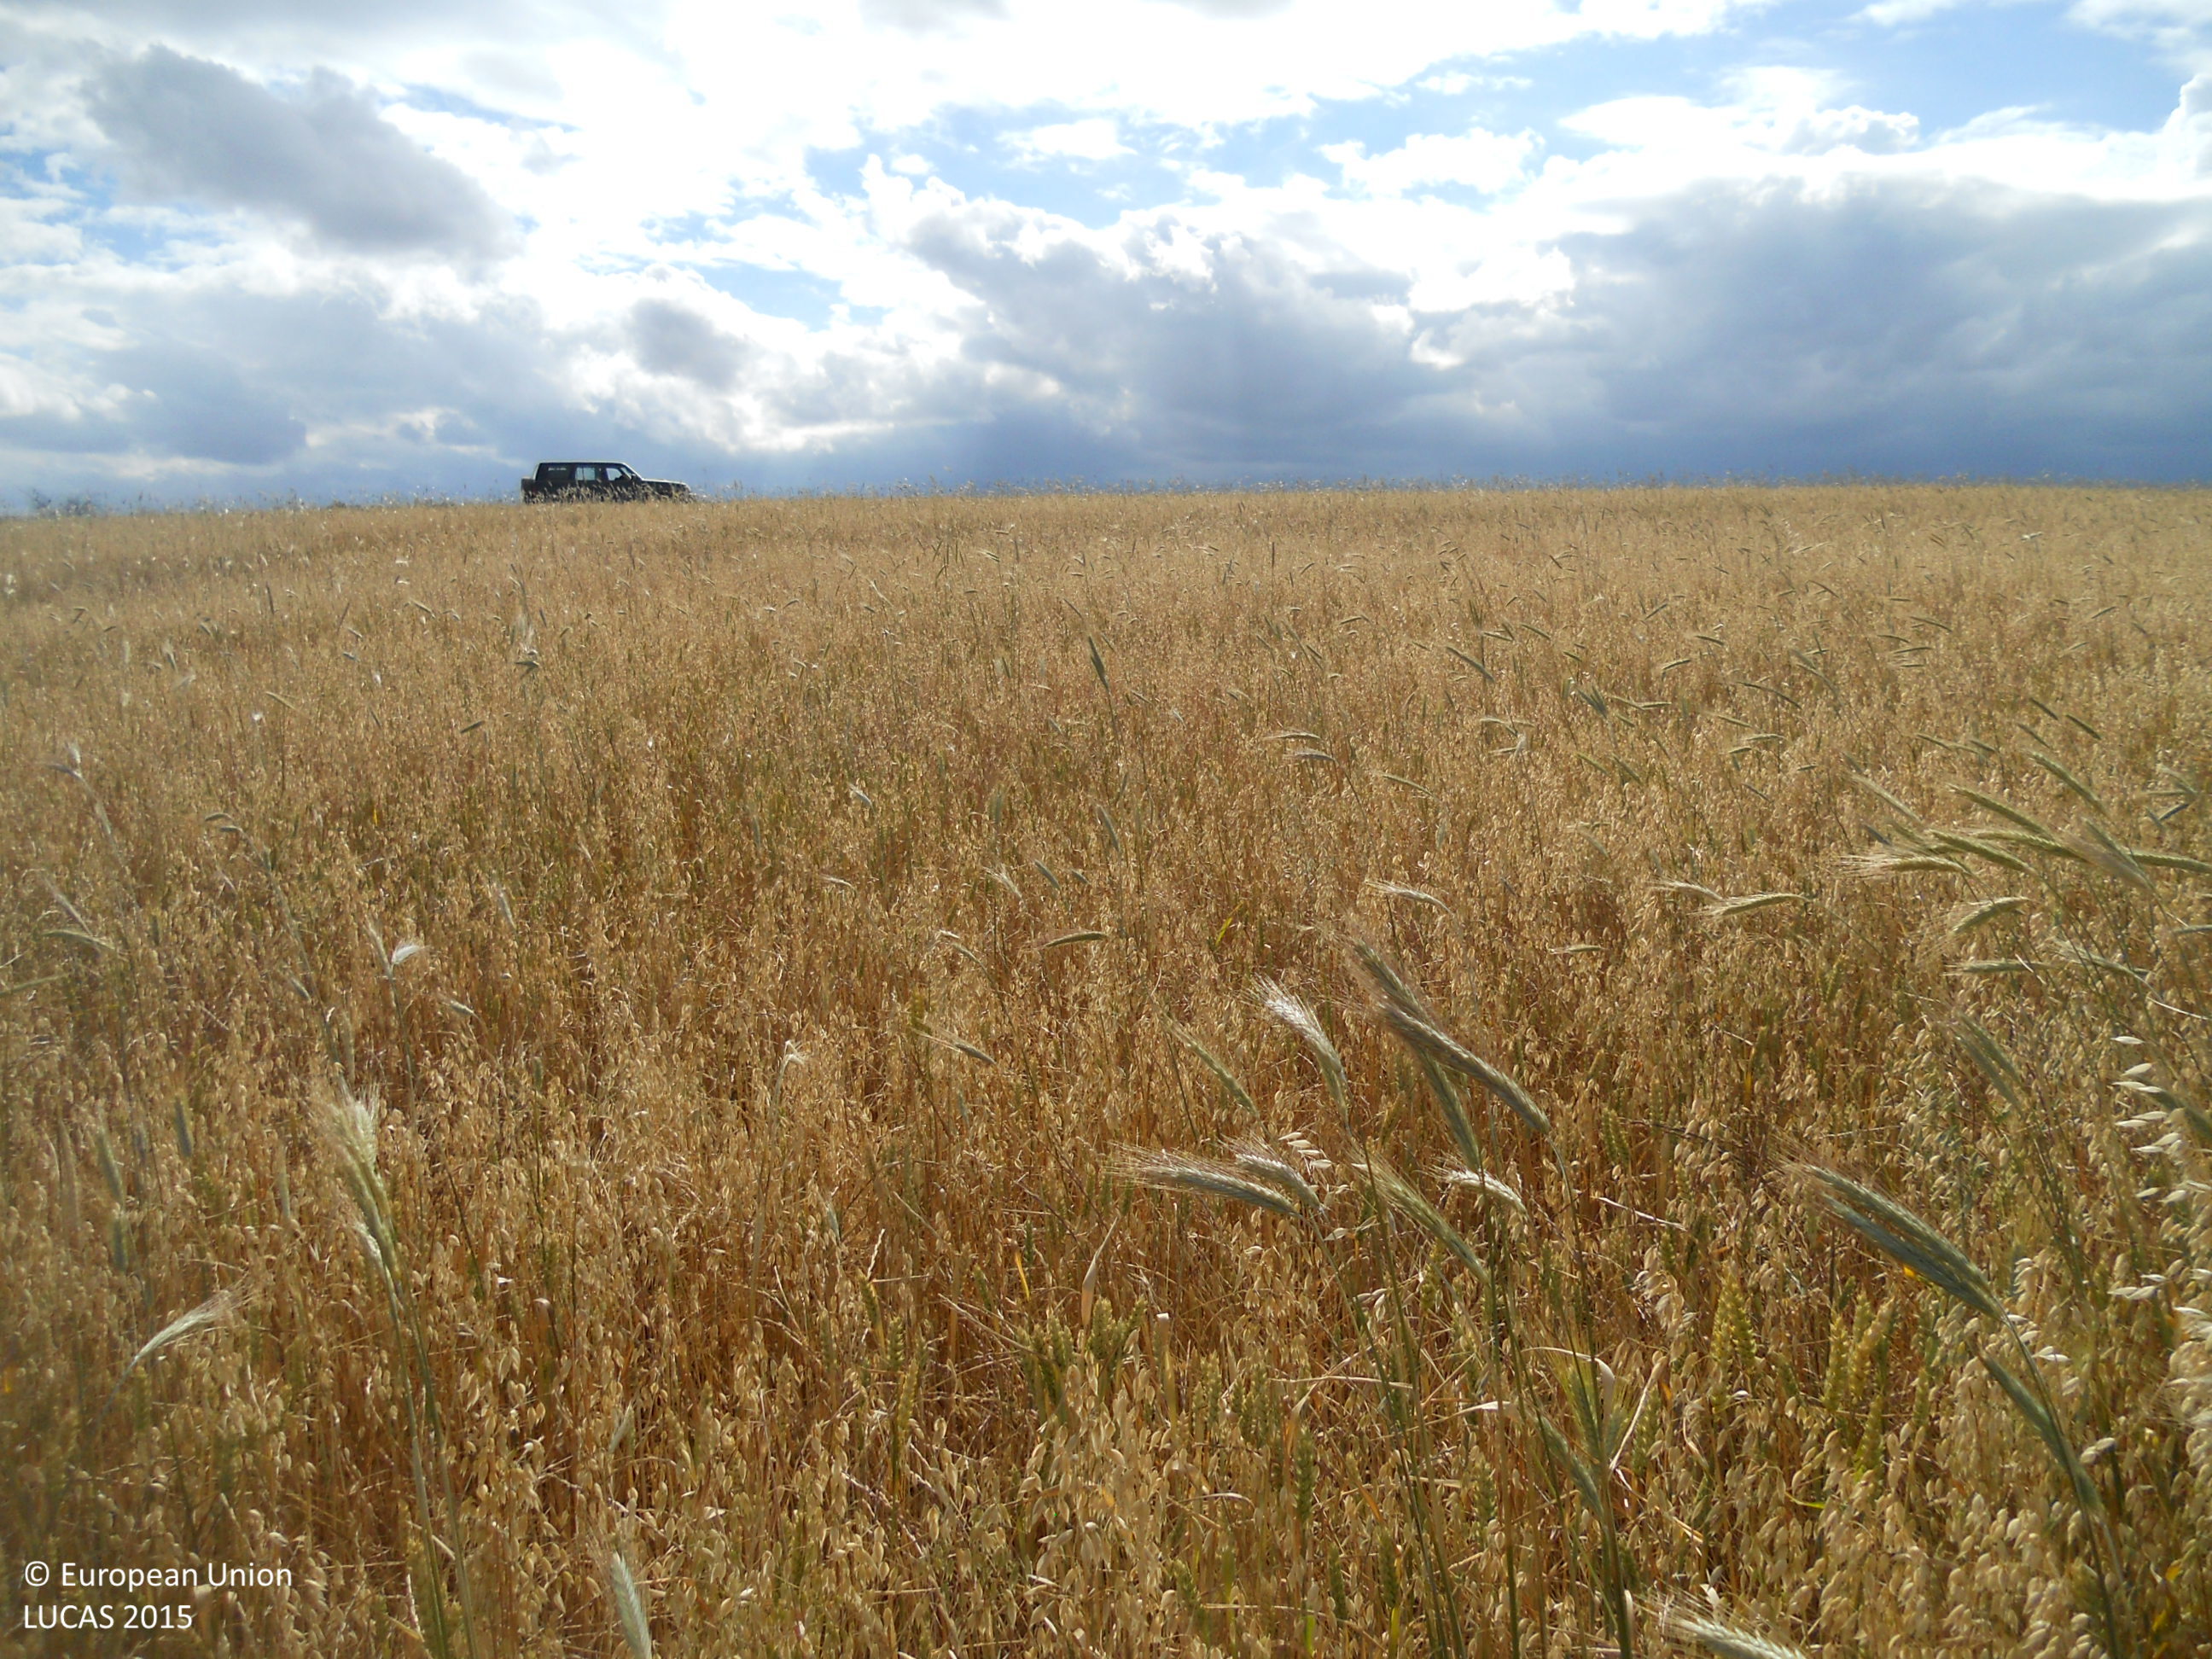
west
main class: Cropland
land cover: Mixed cereals for fodder
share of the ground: > 75 %
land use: Agriculture (excluding fallow land and kitchen gardens)
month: June
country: ES
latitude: 42.3404
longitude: -4.8514
